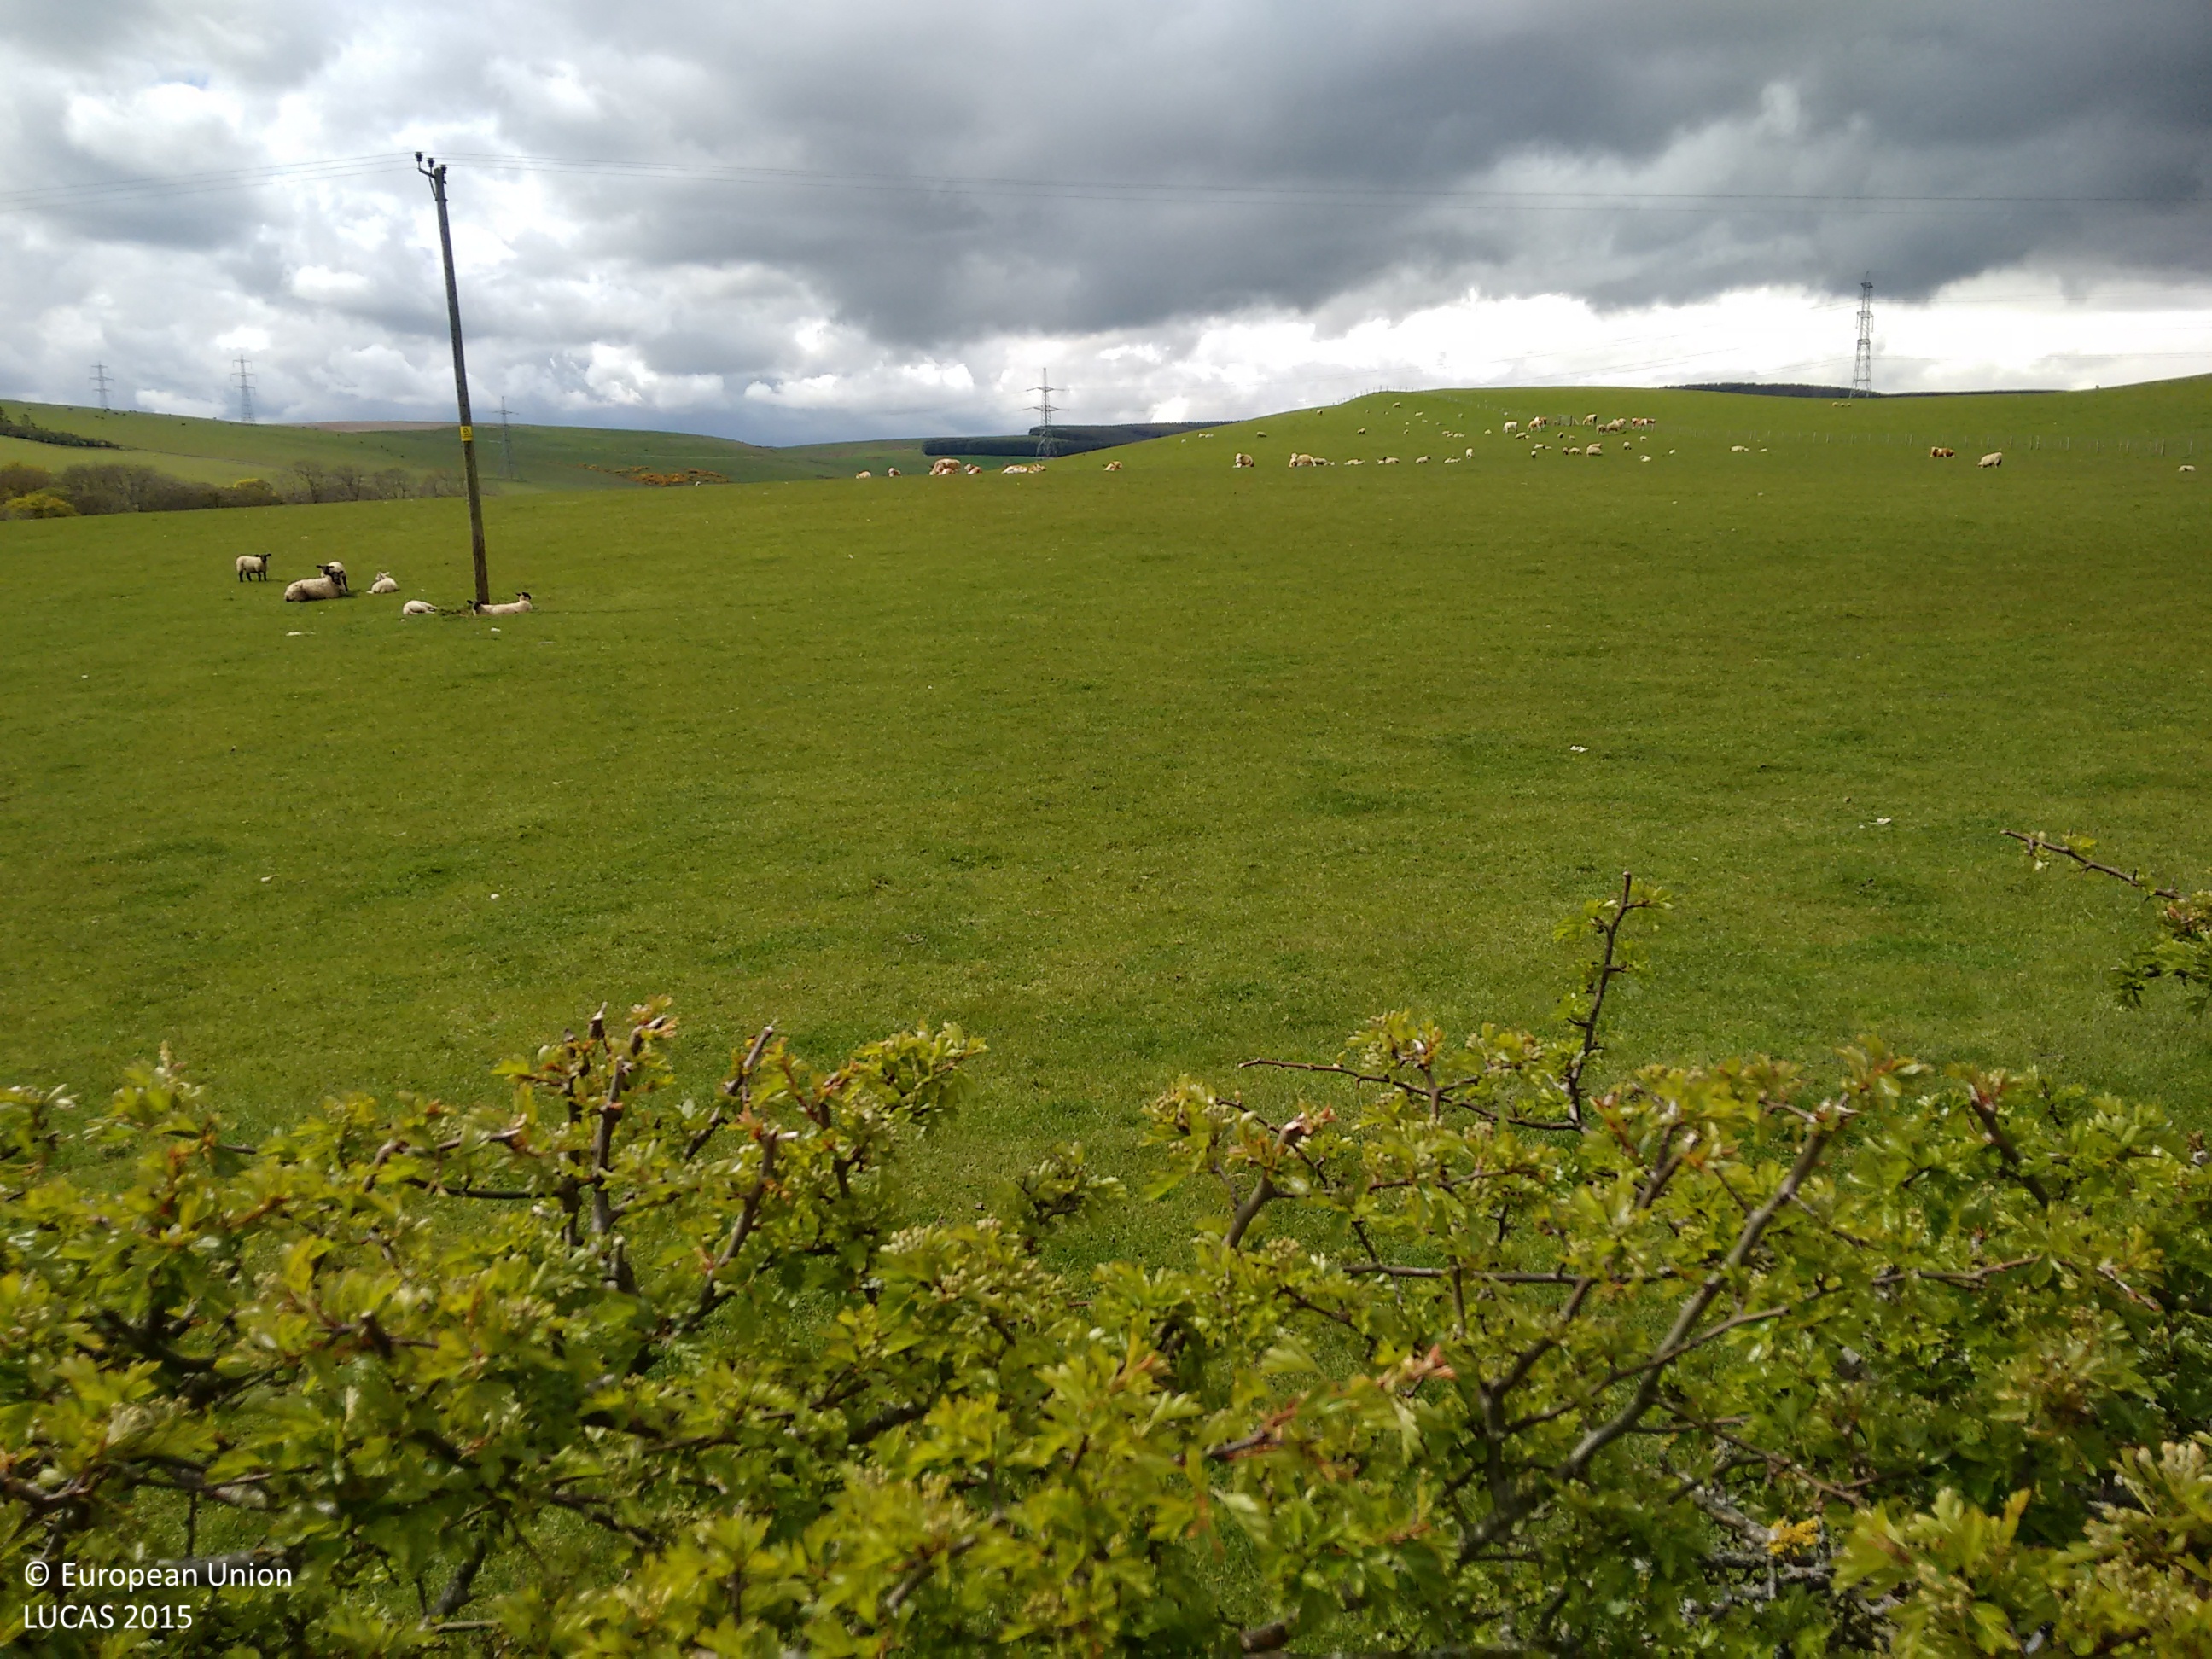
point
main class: Grassland
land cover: Grassland without tree/shrub cover
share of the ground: > 75 %
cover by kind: herbaceous plants 100 %
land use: Agriculture (excluding fallow land and kitchen gardens)
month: May
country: GB
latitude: 55.9120
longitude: -2.3925
